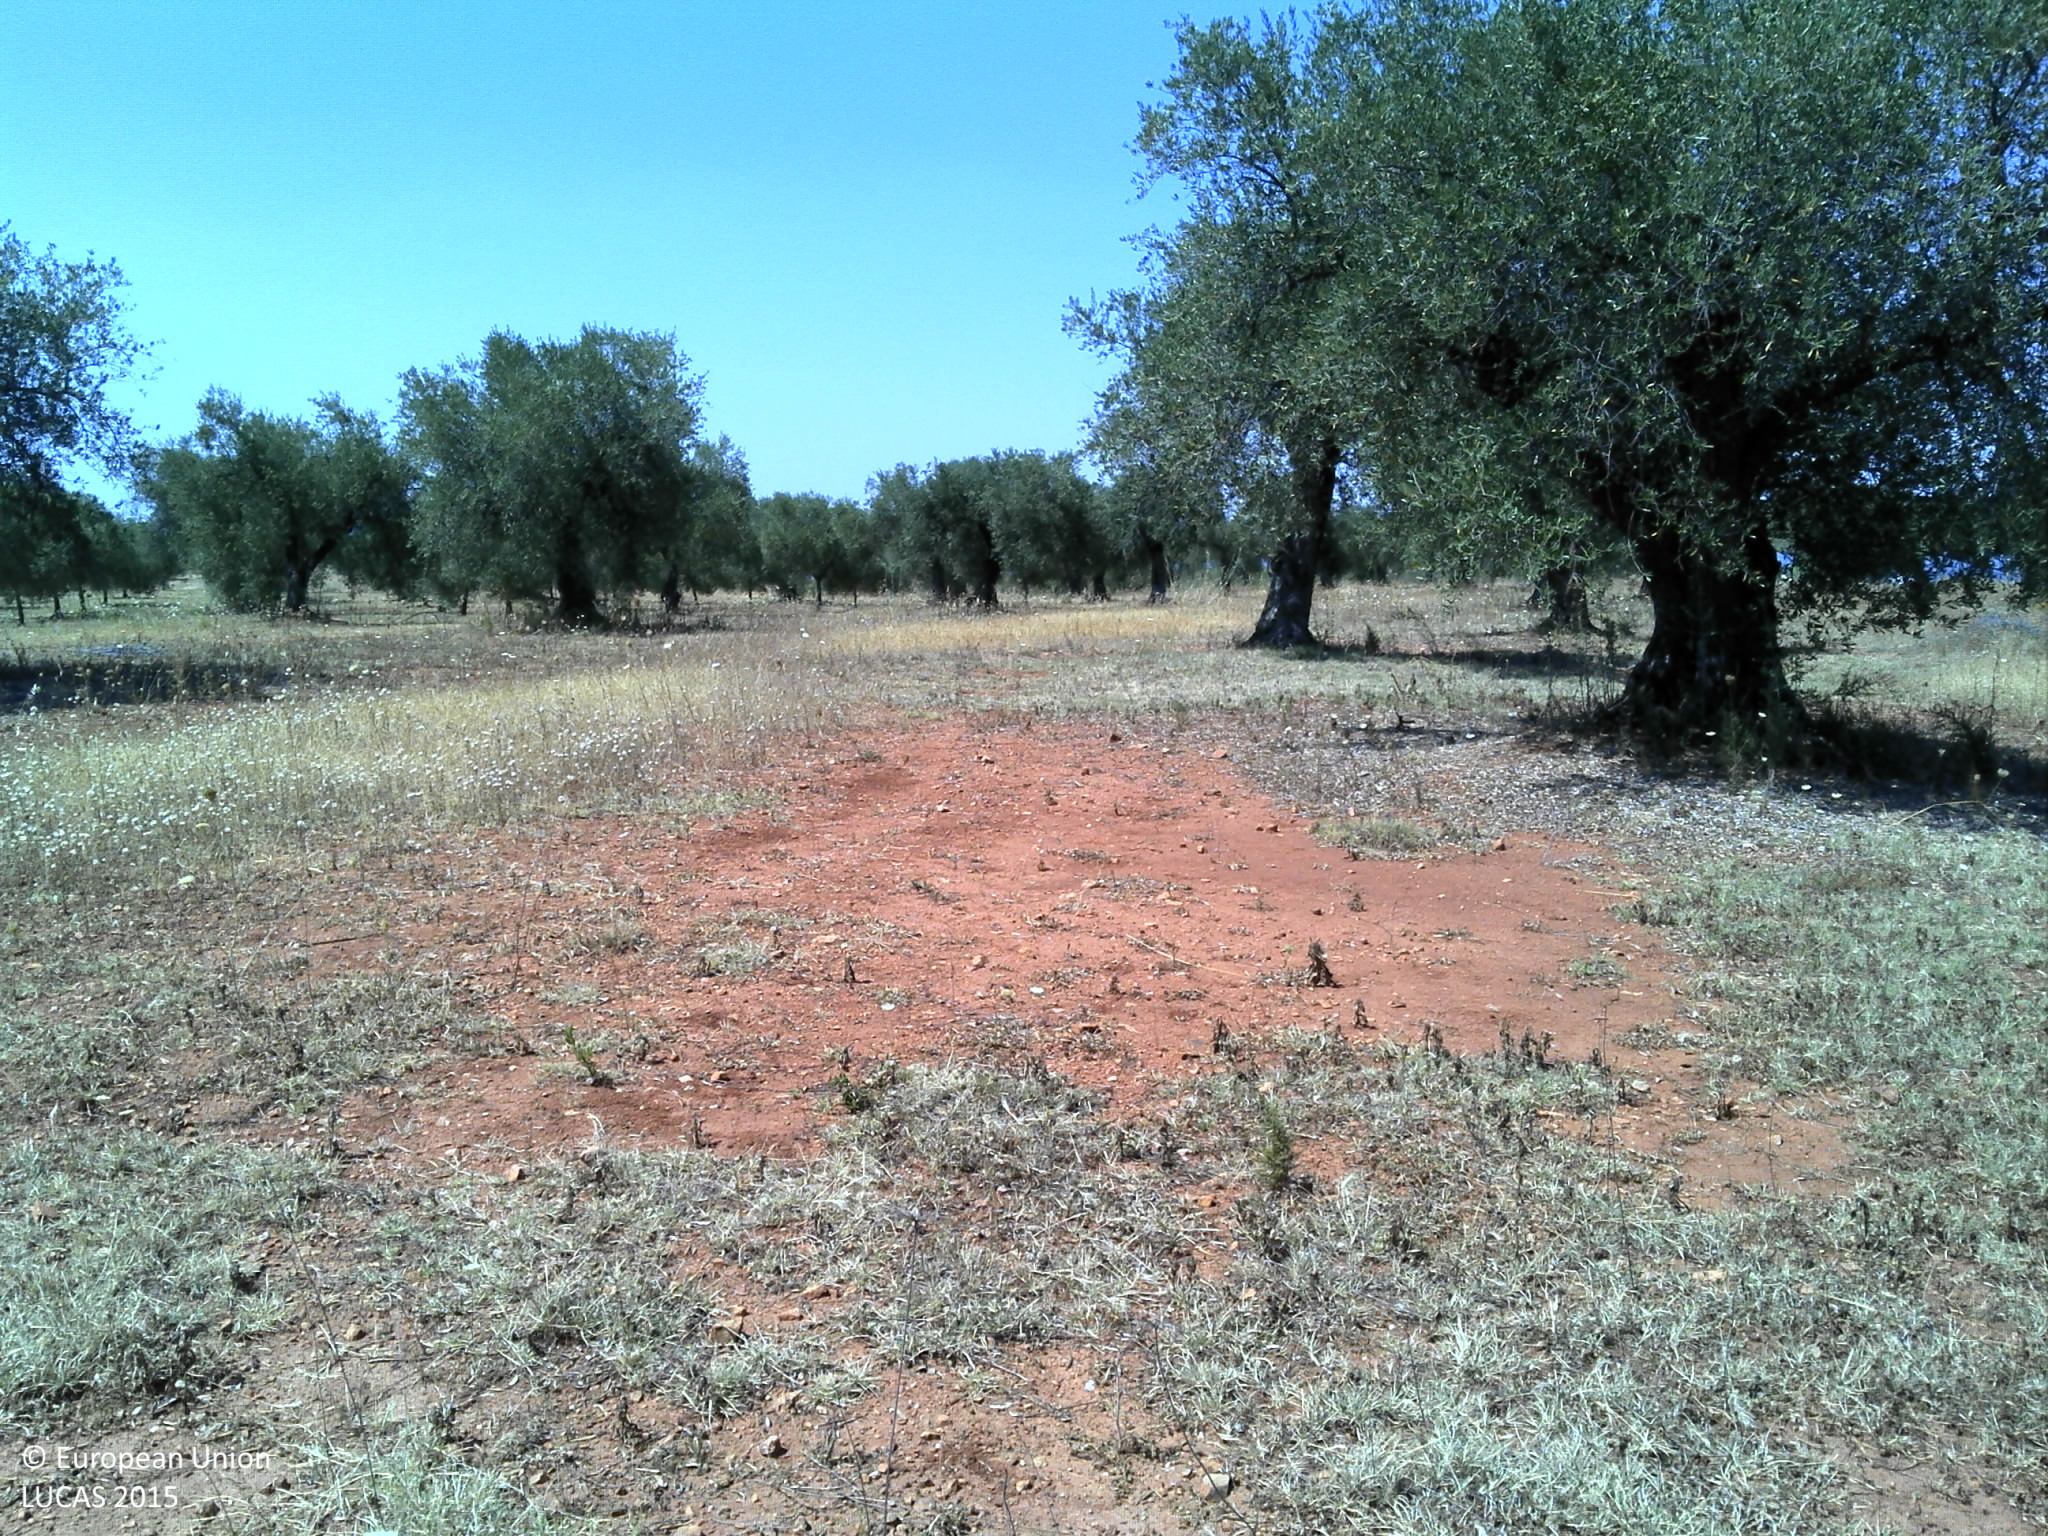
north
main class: Cropland
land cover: Olive groves
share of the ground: 25 - 50 %
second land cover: Grassland without tree/shrub cover
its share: 10 - 25 %
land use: Agriculture (excluding fallow land and kitchen gardens)
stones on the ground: < 10 %
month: June
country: PT
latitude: 38.0553
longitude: -7.5841
